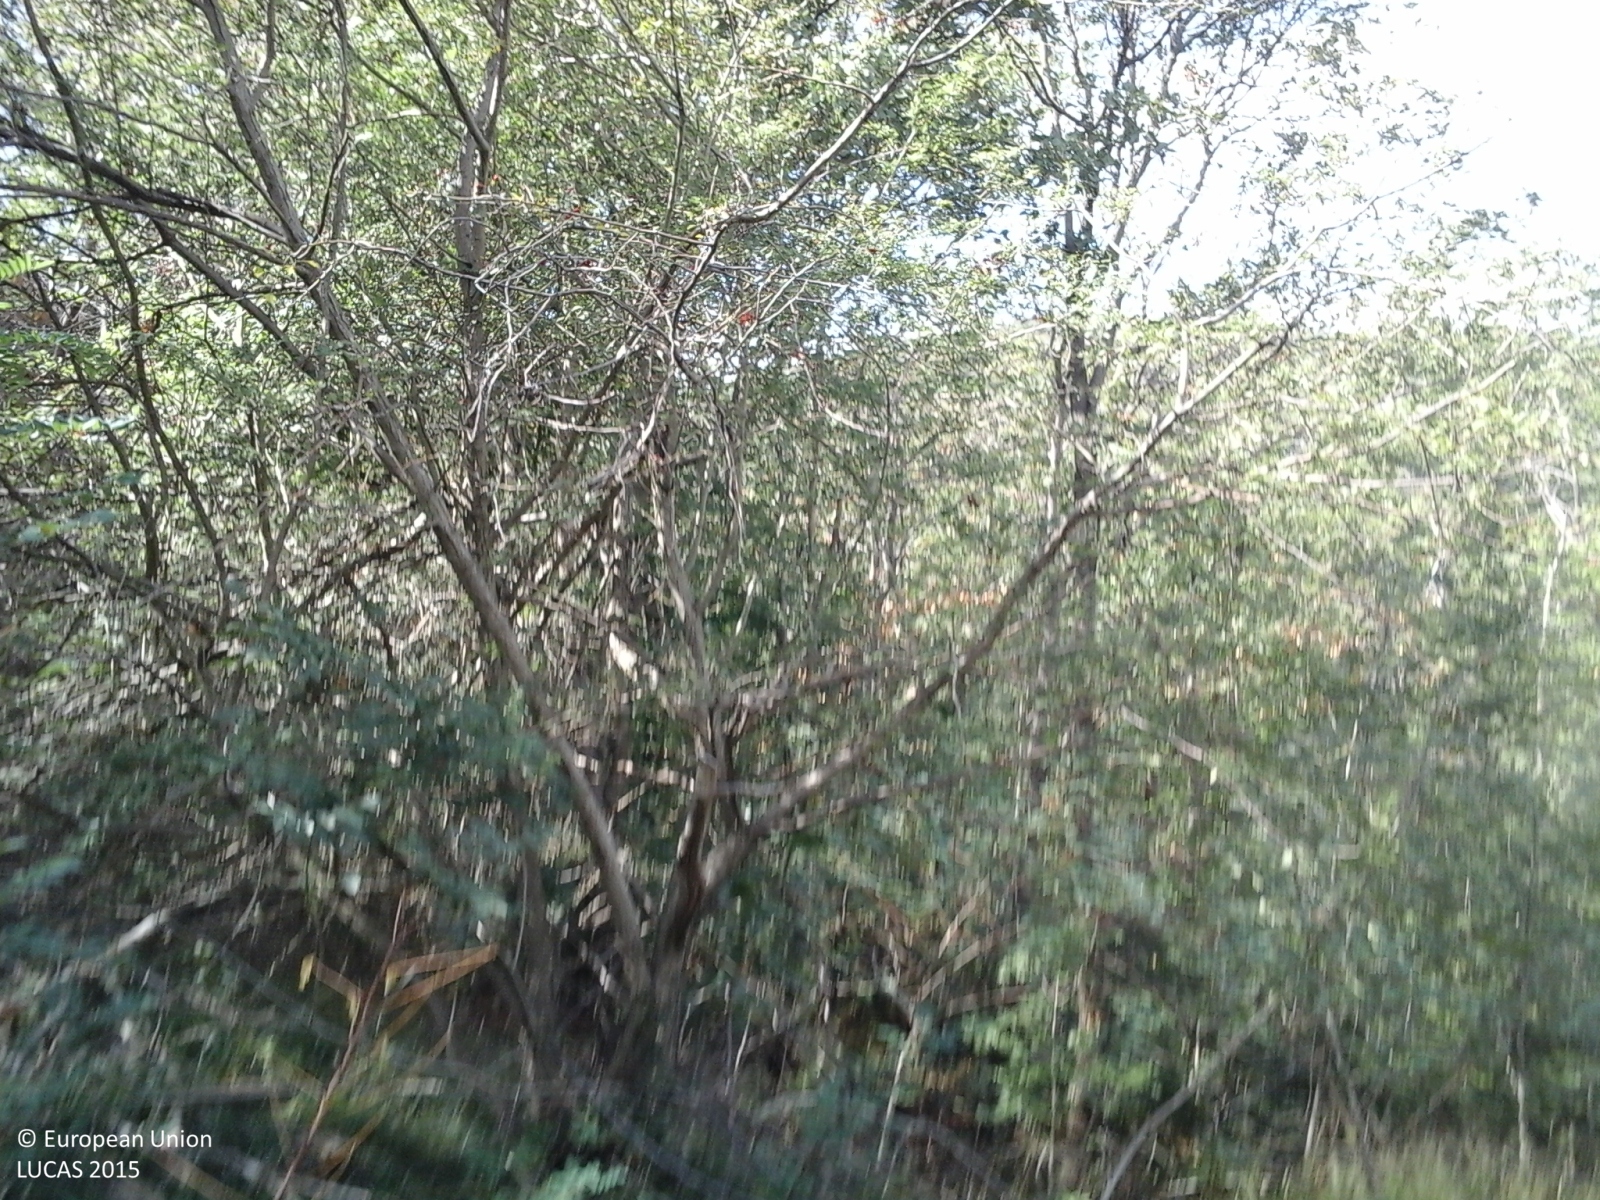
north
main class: Woodland
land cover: Broadleaved woodland
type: thermophilous deciduous forest
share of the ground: > 75 %
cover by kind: broadleaved forest trees 100 %
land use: Semi-natural and natural areas not in use
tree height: > 5 m
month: September
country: IT
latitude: 44.3763
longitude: 8.5349
